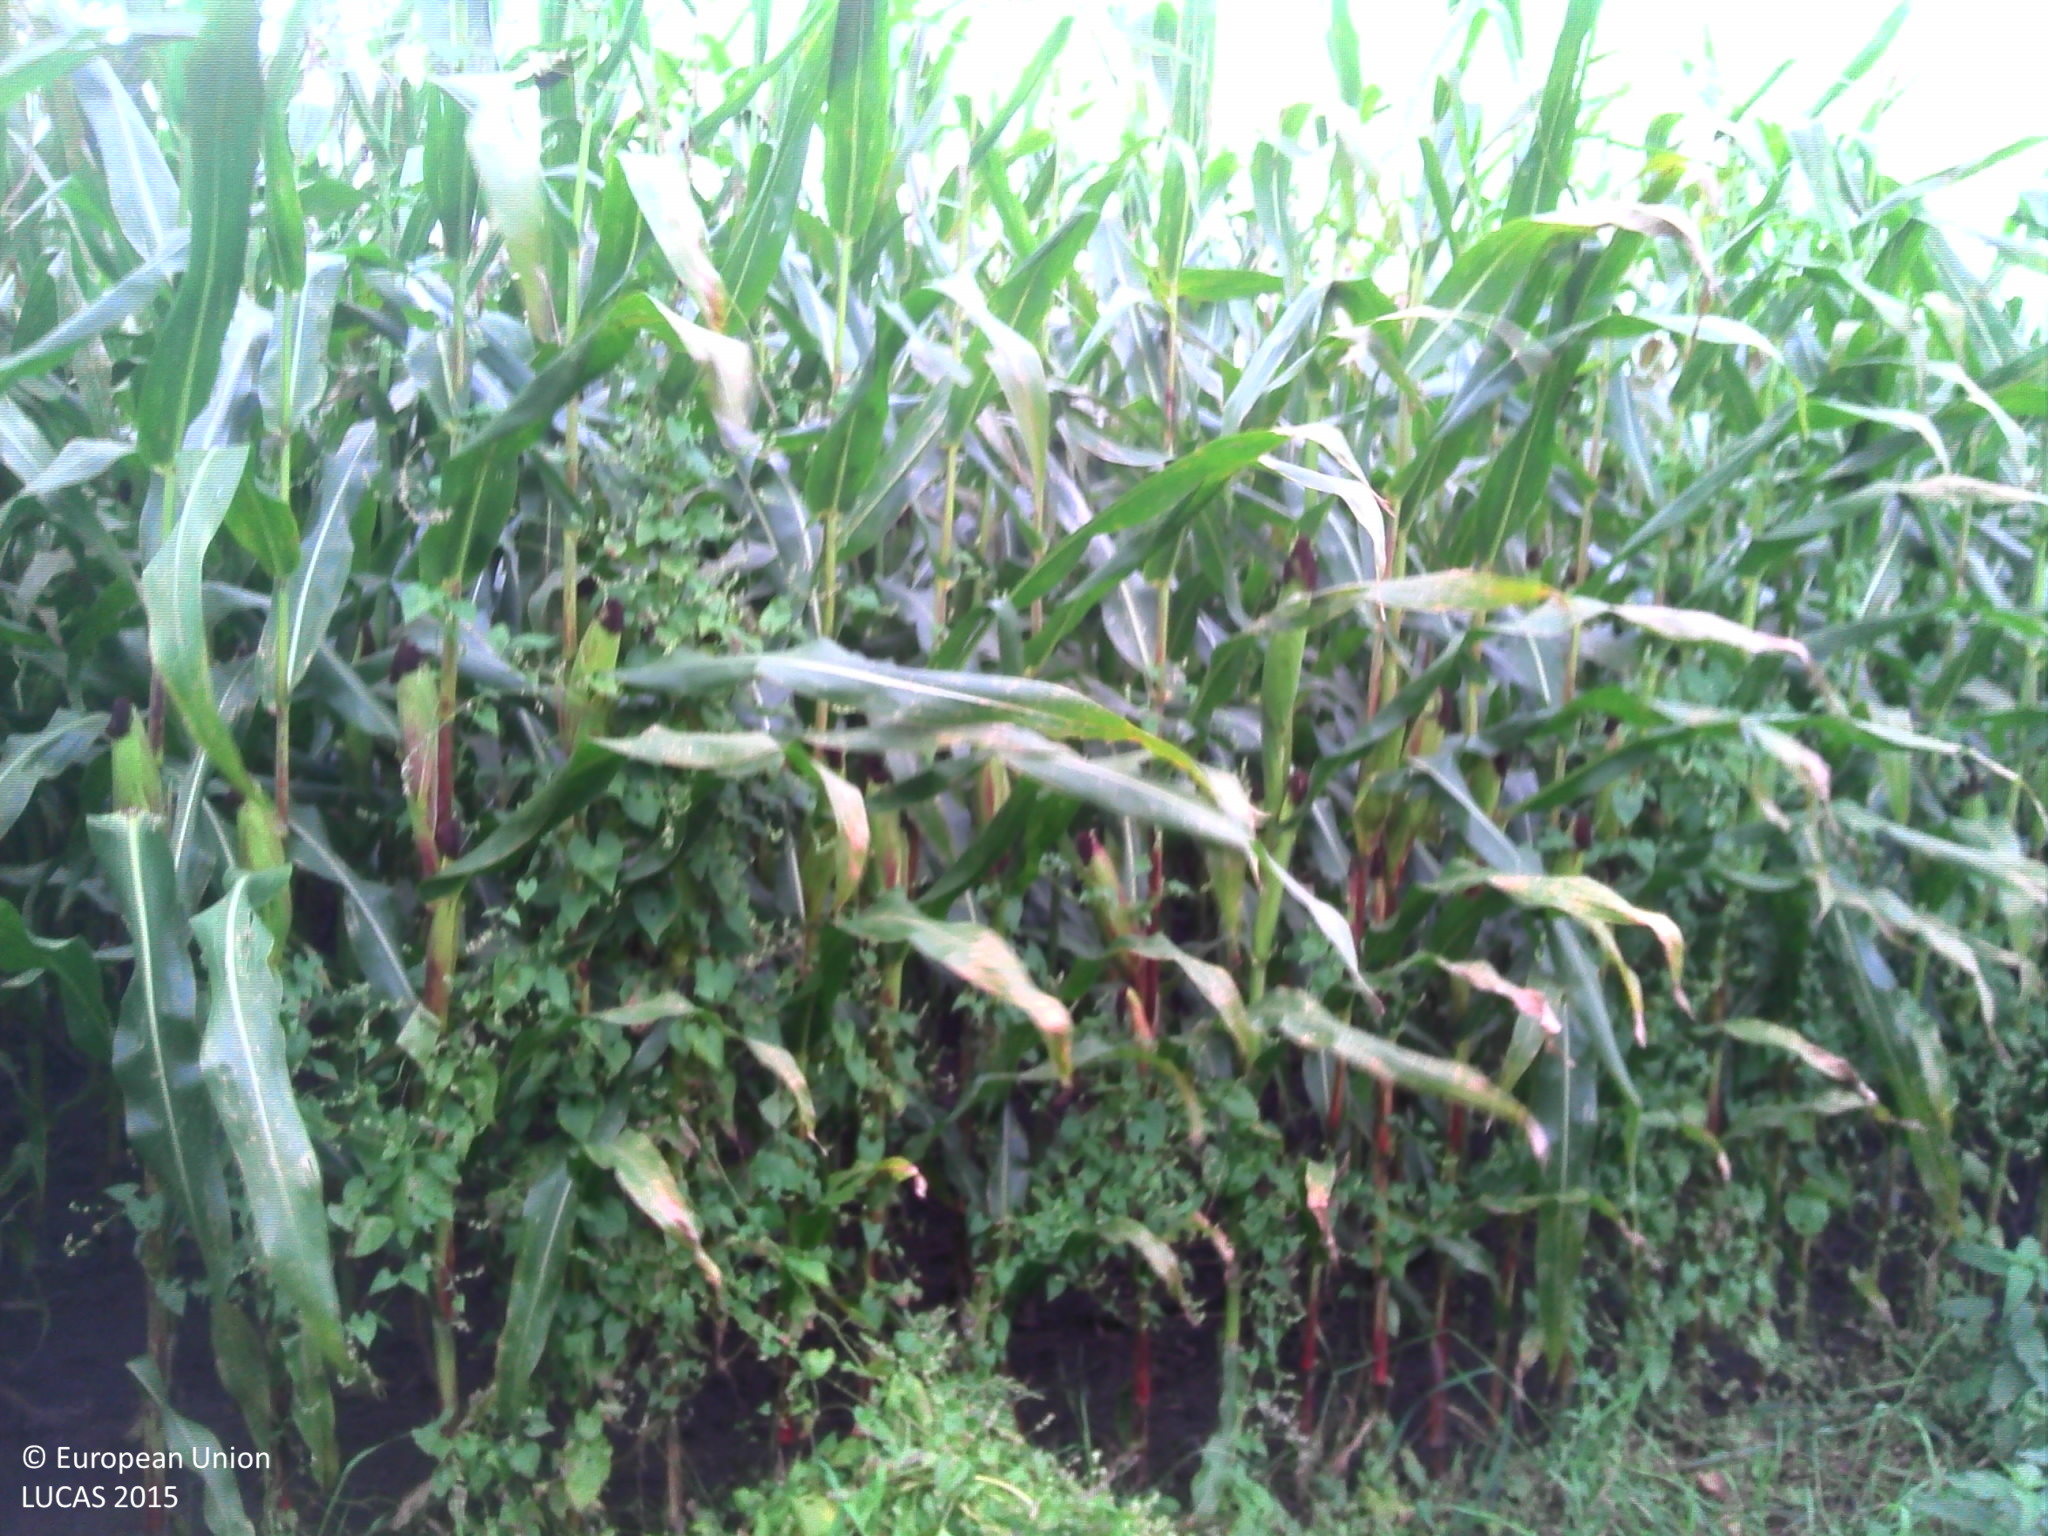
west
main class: Cropland
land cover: Maize
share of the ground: > 75 %
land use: Agriculture (excluding fallow land and kitchen gardens)
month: September
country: BE
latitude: 51.1209
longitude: 2.9461
